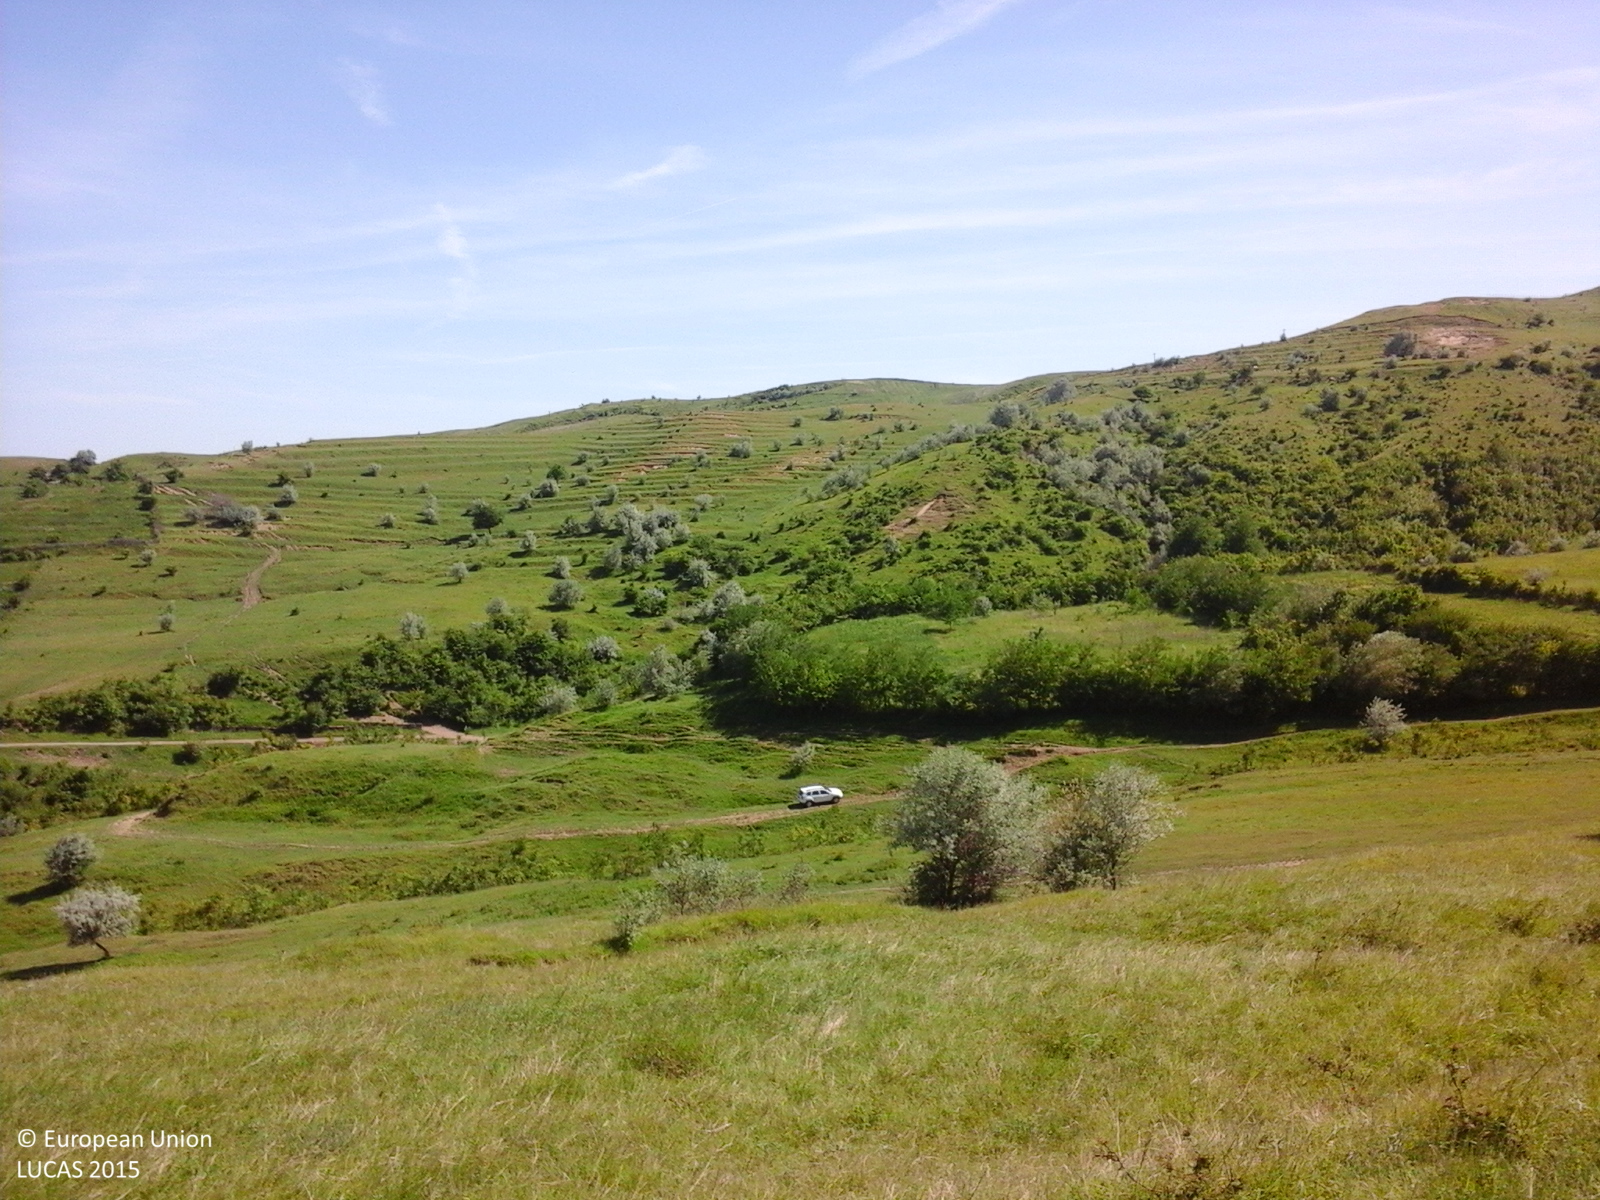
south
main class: Grassland
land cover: Grassland without tree/shrub cover
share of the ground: > 75 %
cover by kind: herbaceous plants 100 %
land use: Agriculture (excluding fallow land and kitchen gardens)
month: June
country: RO
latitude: 44.9941
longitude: 26.2100
